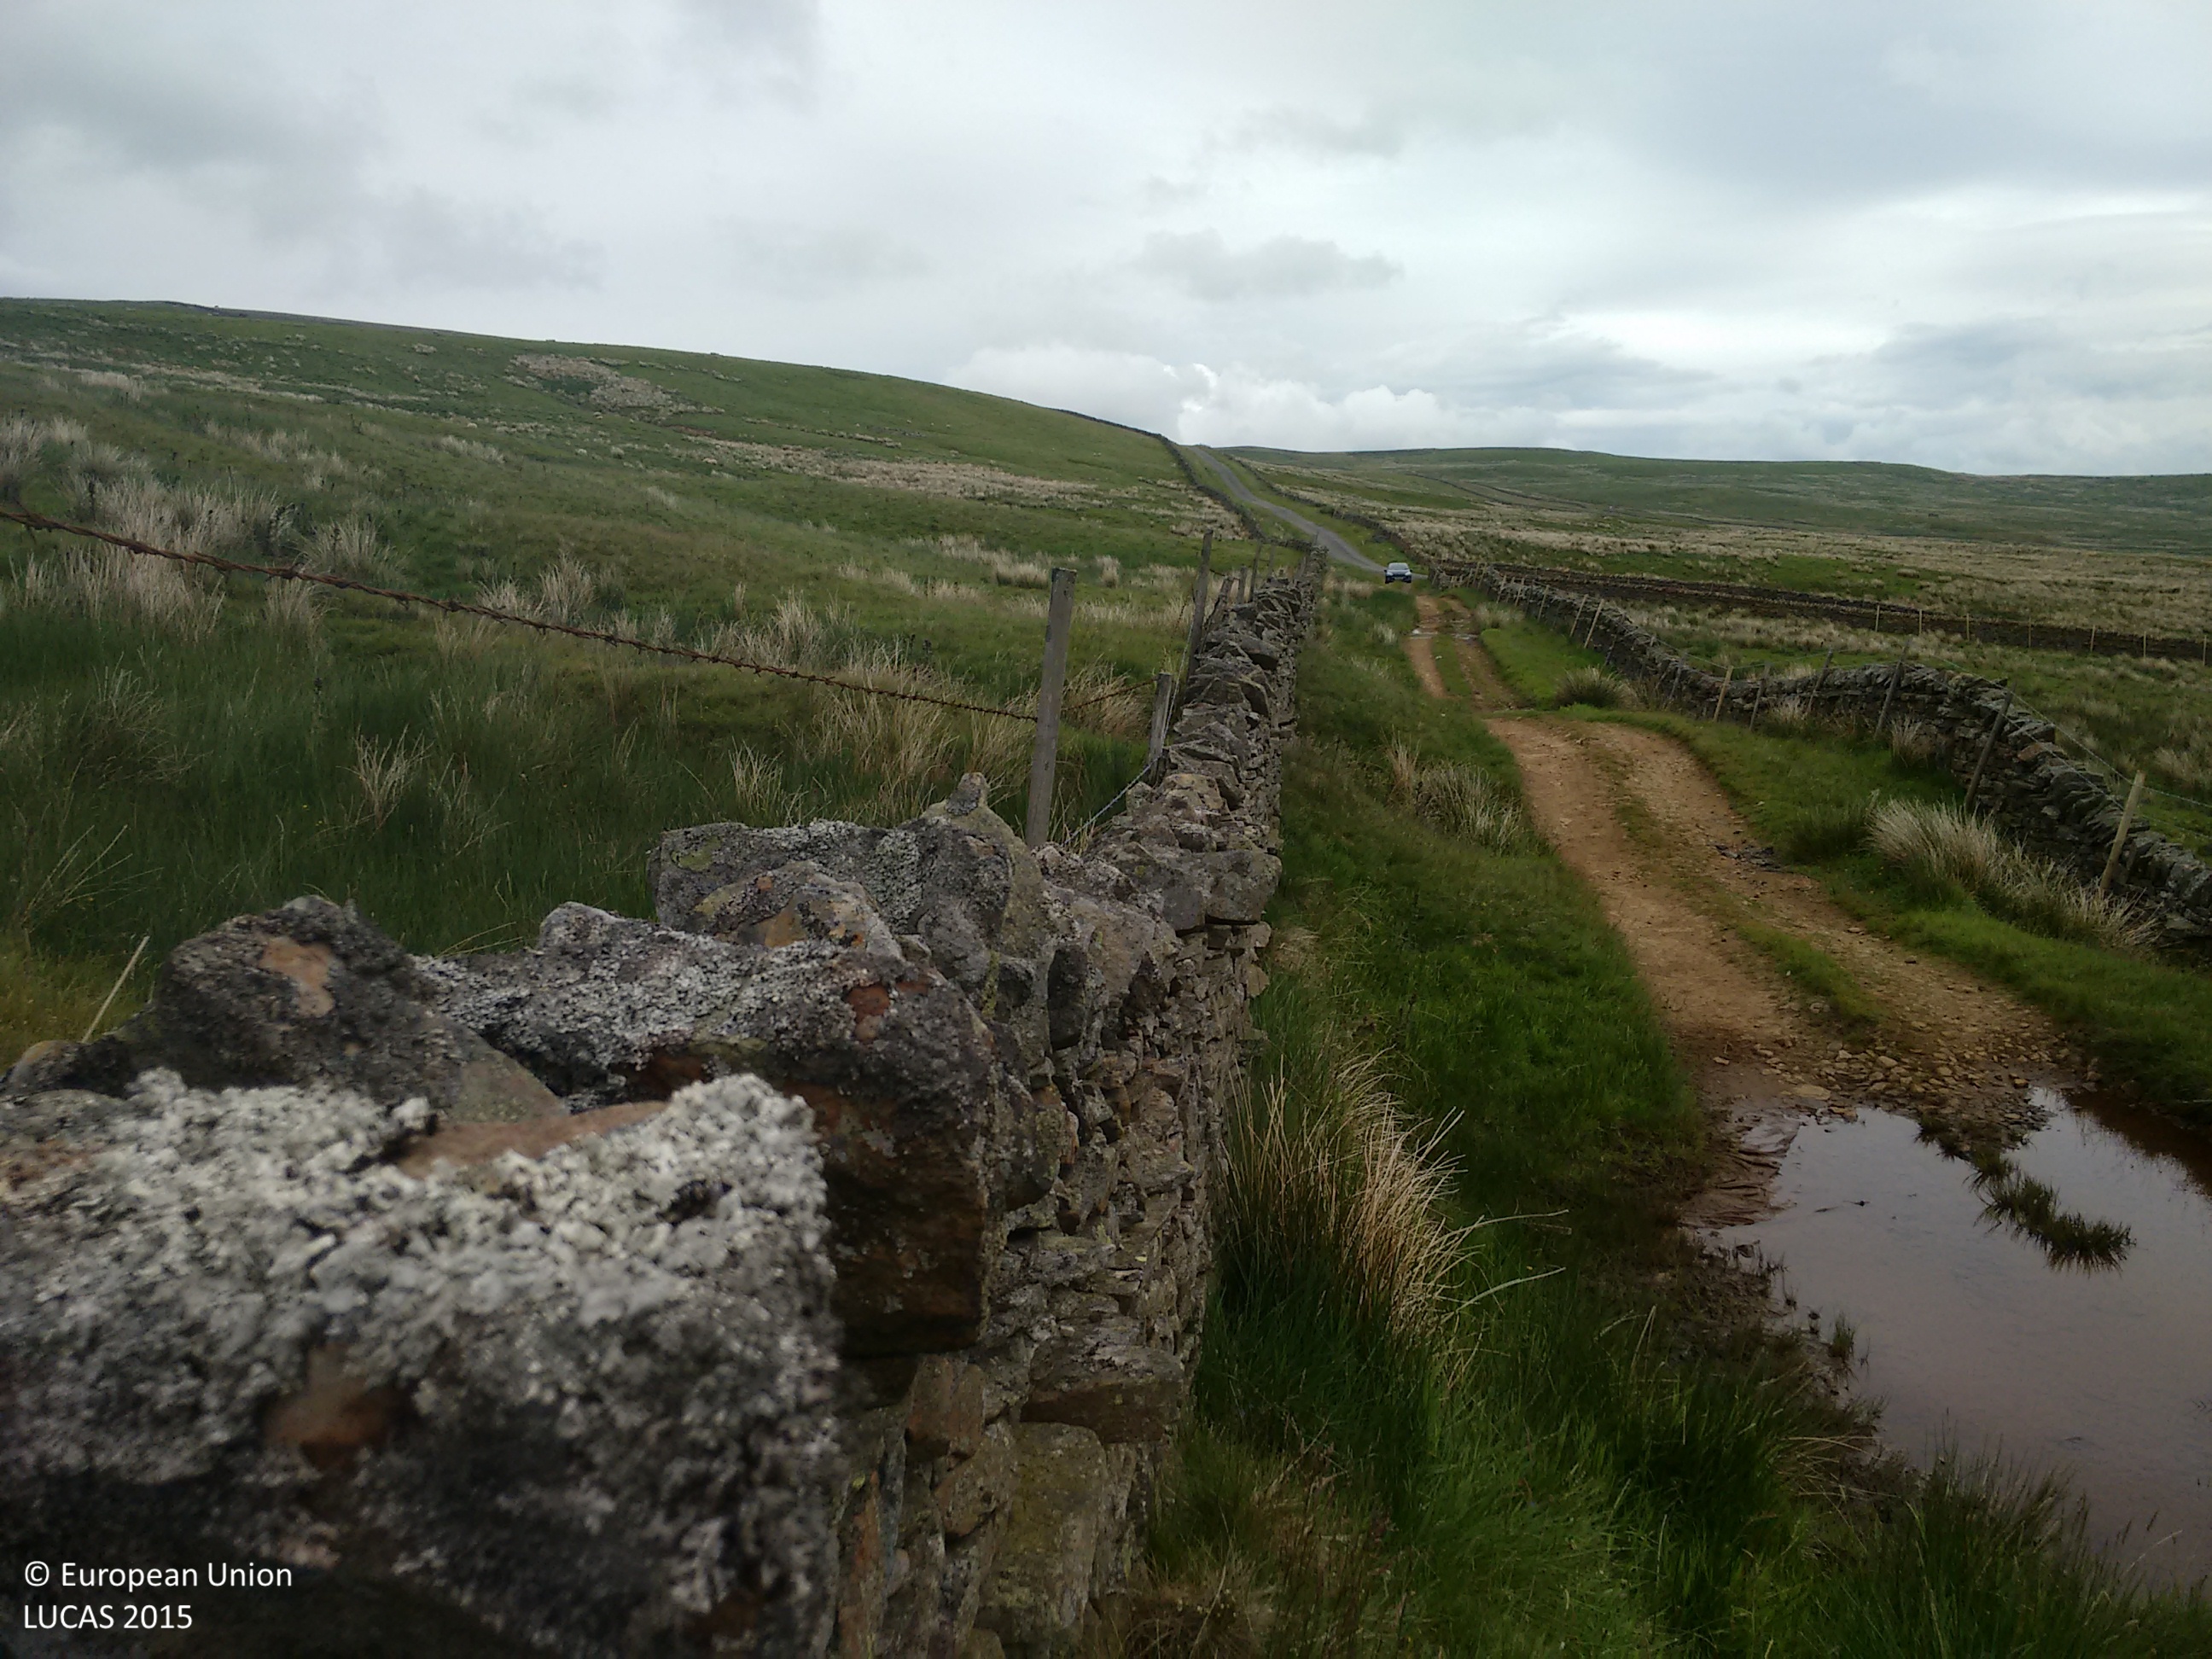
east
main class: Grassland
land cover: Grassland without tree/shrub cover
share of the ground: > 75 %
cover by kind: herbaceous plants 100 %
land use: Agriculture (excluding fallow land and kitchen gardens)
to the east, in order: Grassland without tree/shrub cover; Inland marshes; Grassland without tree/shrub cover
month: June
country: GB
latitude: 54.7689
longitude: -2.1663
